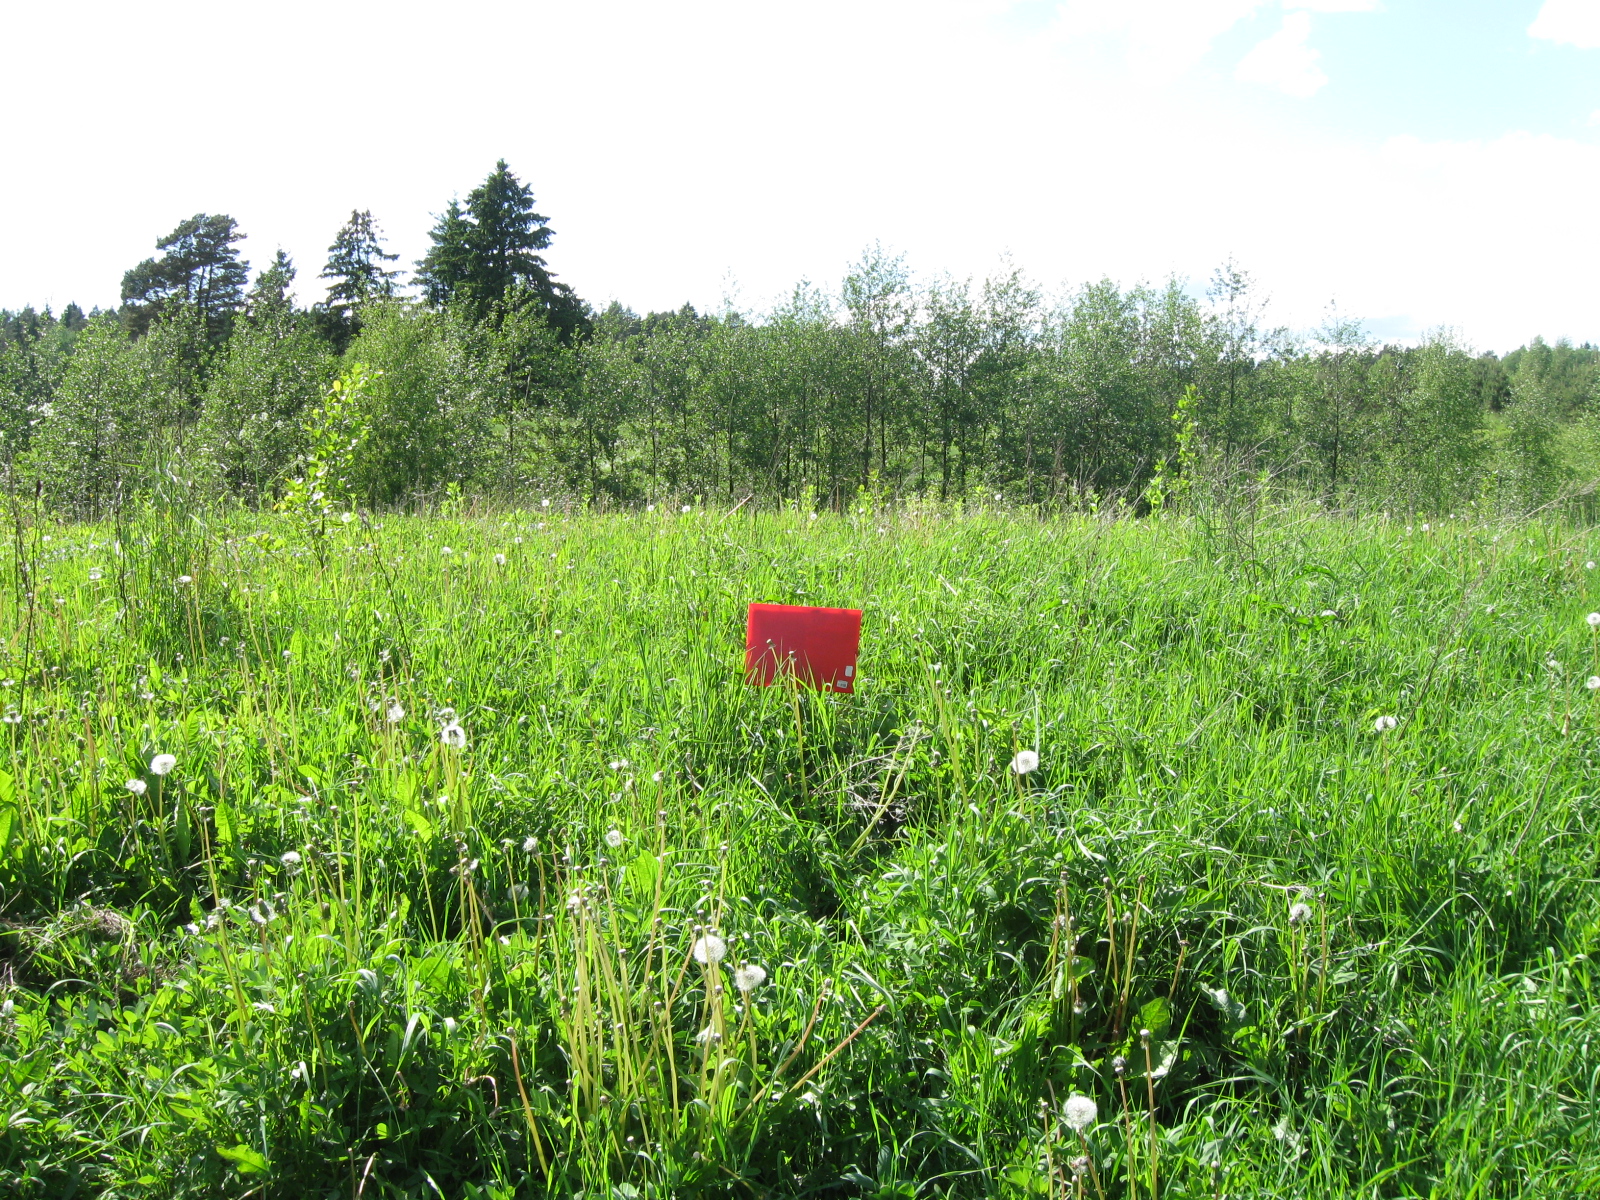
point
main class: Grassland
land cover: Grassland with sparse tree/shrub cover
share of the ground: > 75 %
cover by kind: herbaceous plants 95 %, broadleaved forest trees 5 %
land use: Abandoned areas
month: May
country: LT
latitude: 54.2415
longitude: 23.3840
